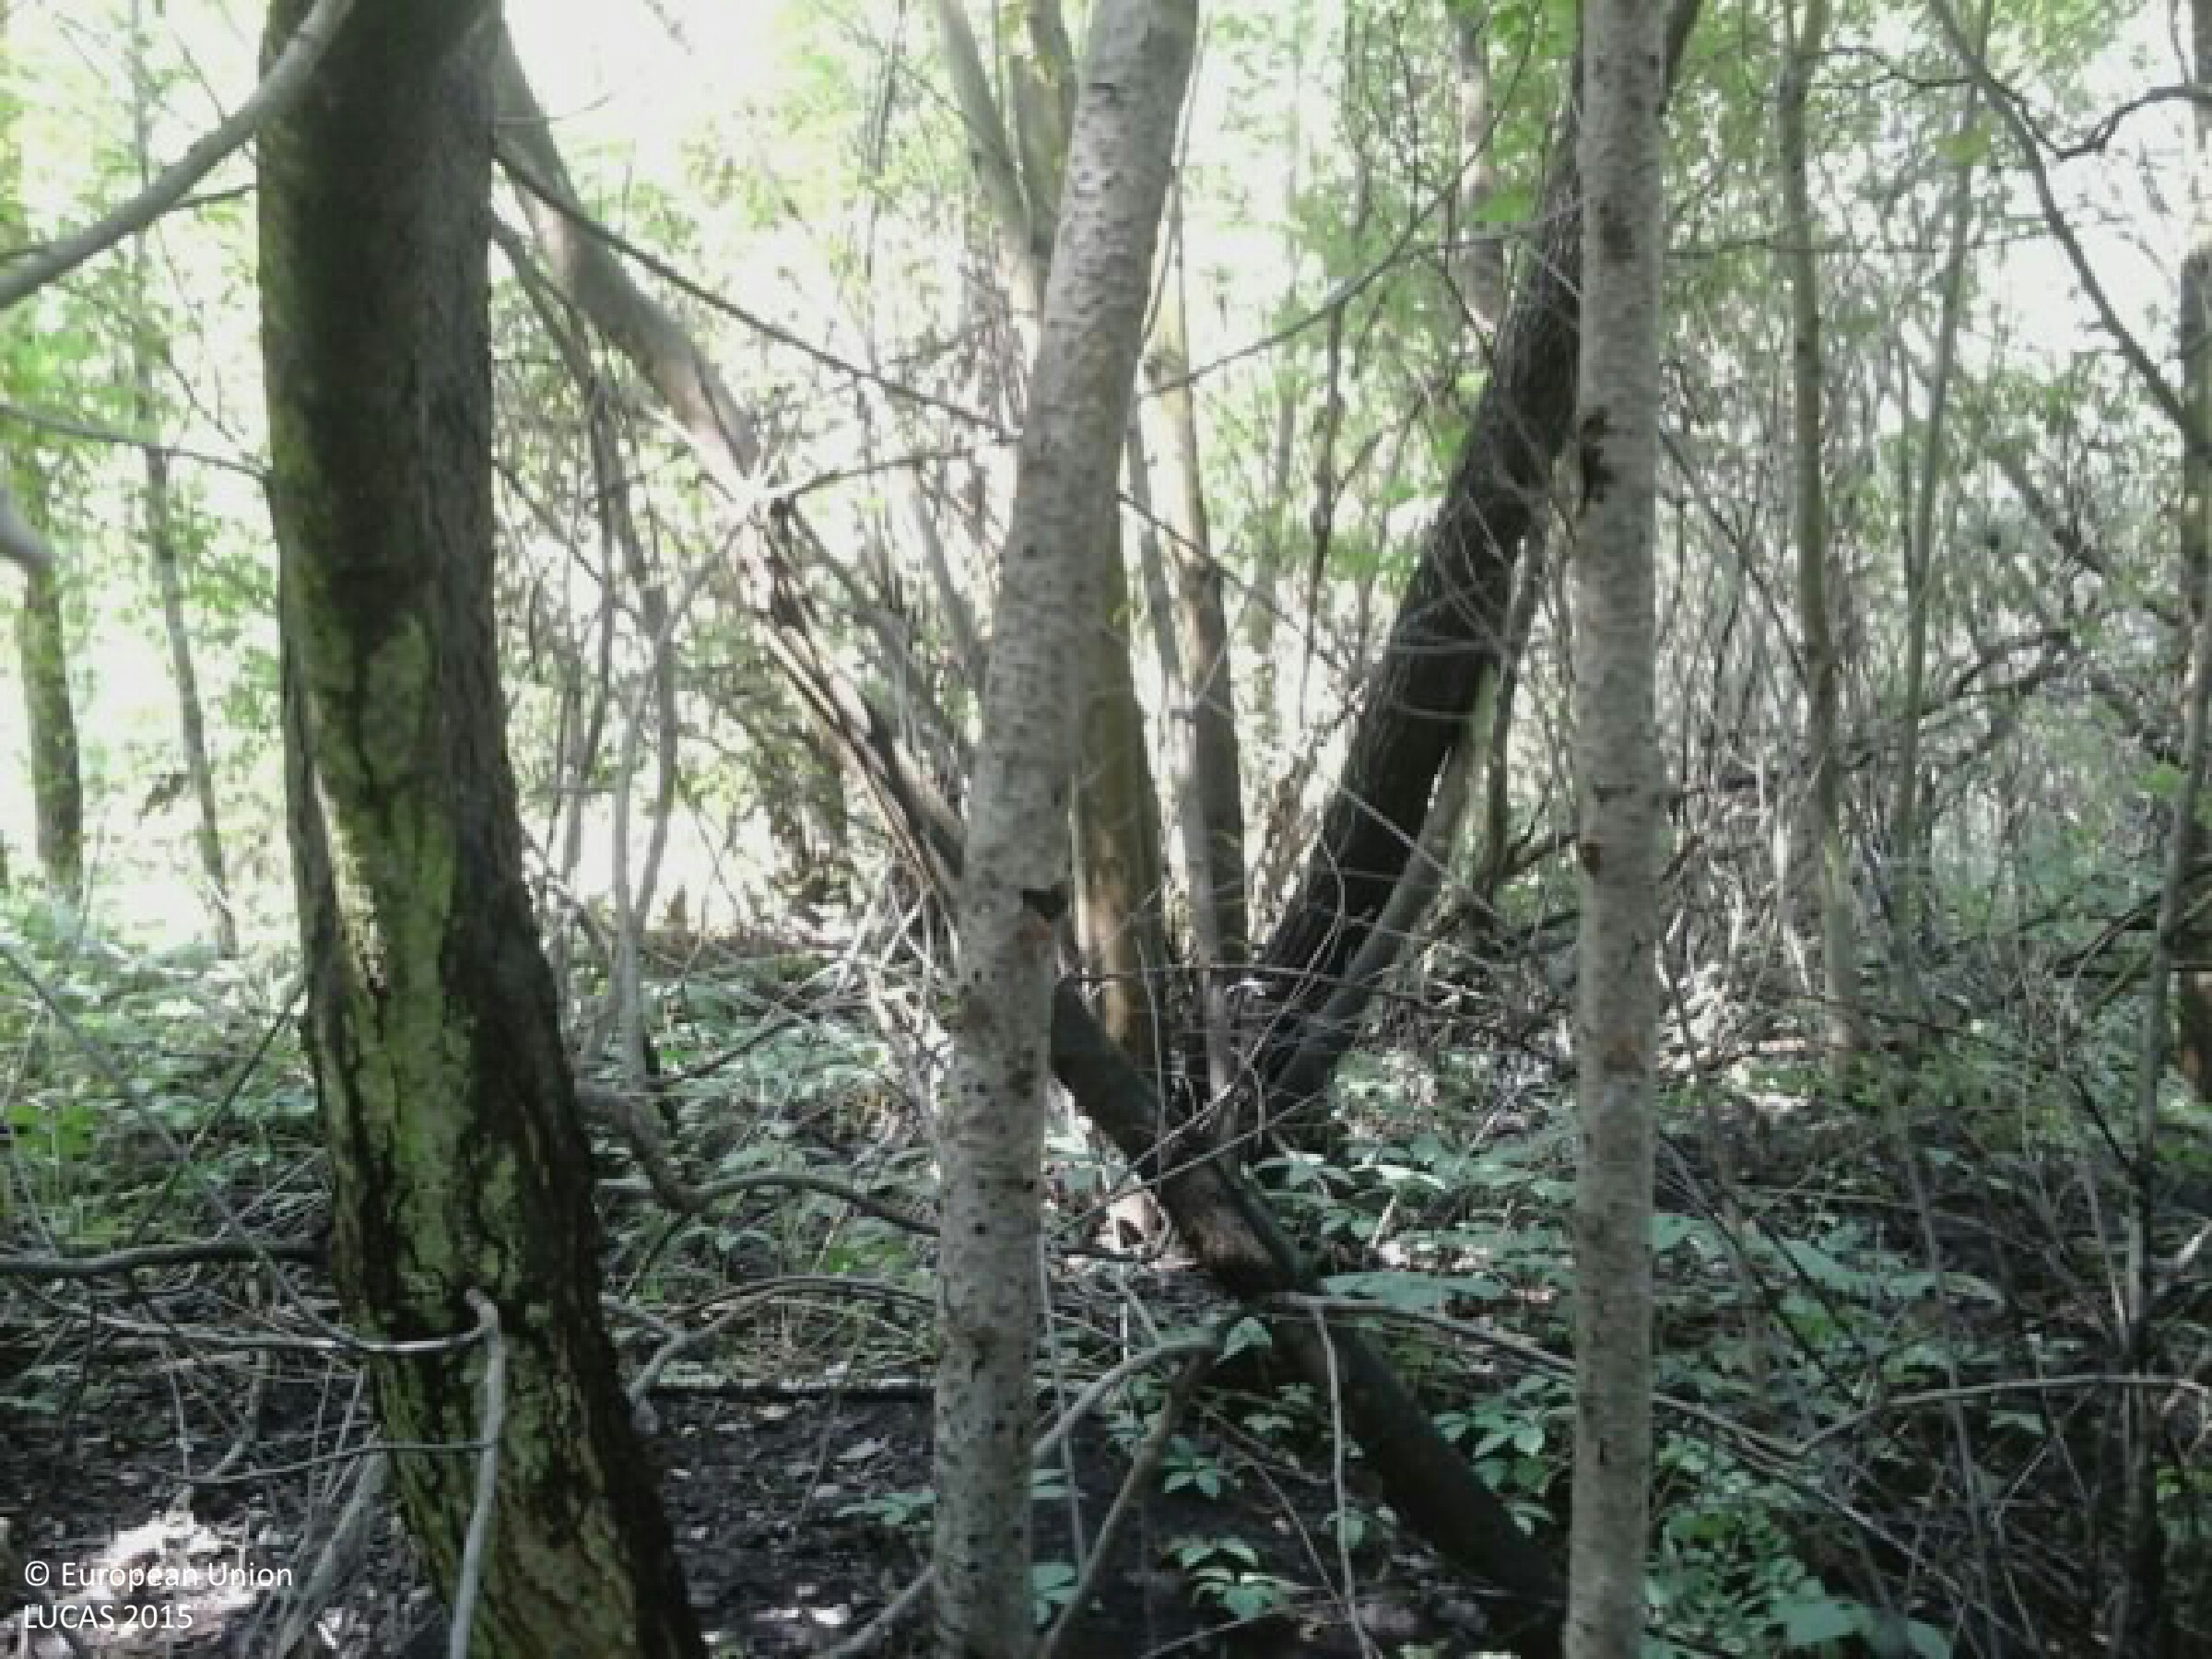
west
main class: Woodland
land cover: Broadleaved woodland
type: mesophytic deciduous forest
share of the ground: > 75 %
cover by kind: broadleaved forest trees 85 %, shrubs 10 %, herbaceous plants 5 %
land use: Forestry
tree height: > 5 m
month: August
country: HU
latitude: 47.1613
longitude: 19.6906
